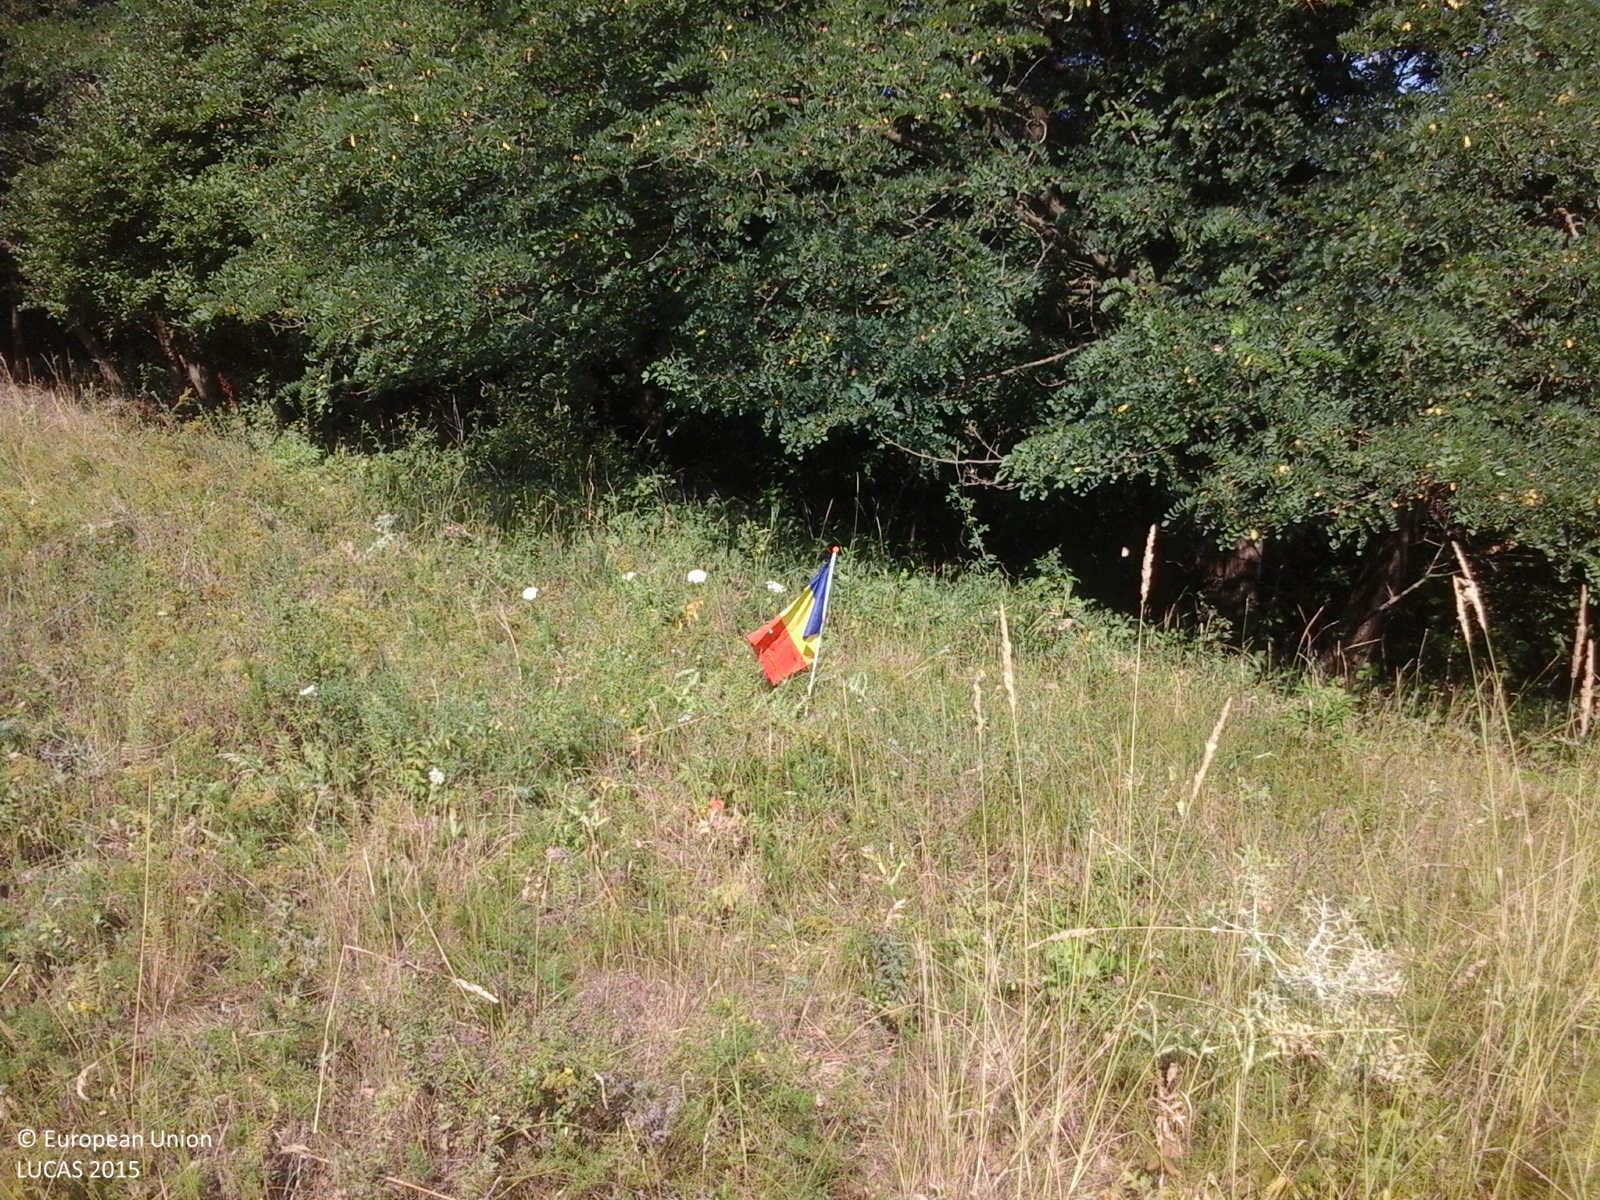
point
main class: Grassland
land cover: Grassland without tree/shrub cover
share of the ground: > 75 %
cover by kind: herbaceous plants 100 %
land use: Agriculture (excluding fallow land and kitchen gardens)
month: July
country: RO
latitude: 46.5495
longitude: 27.1734
